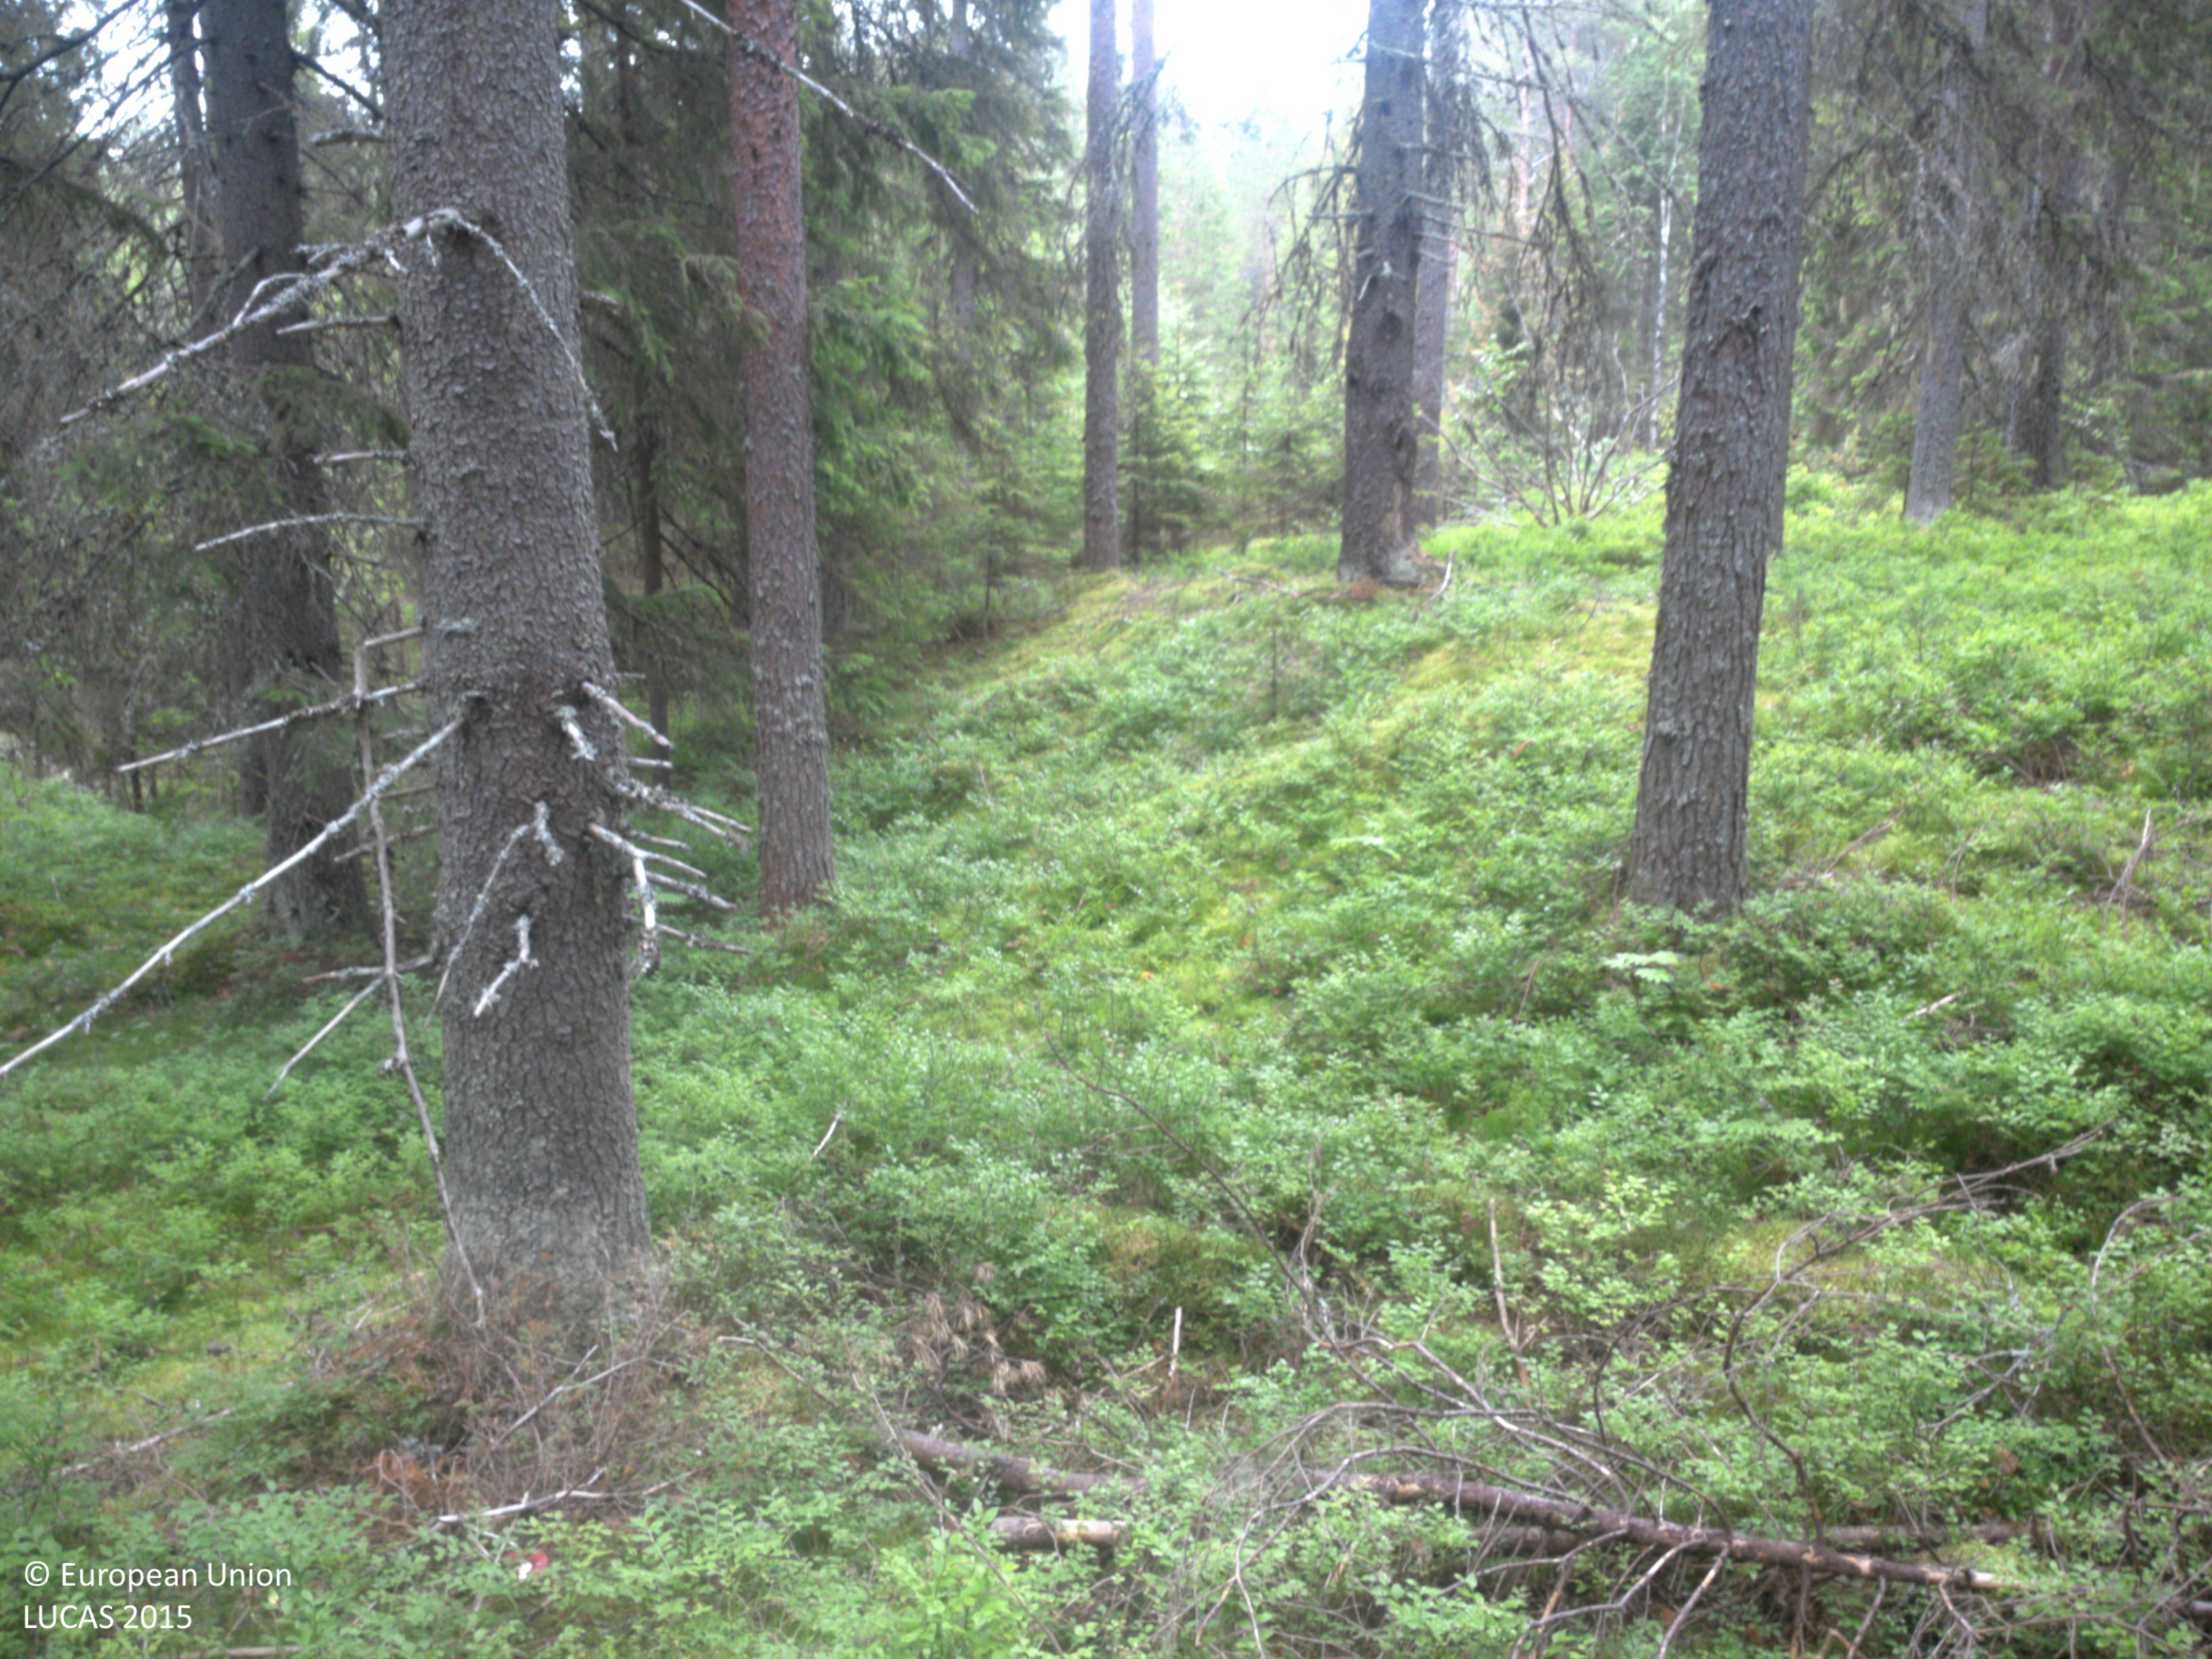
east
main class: Woodland
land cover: Other coniferous woodland
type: boreal forest
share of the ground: 50 - 75 %
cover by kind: coniferous forest trees 50 %, shrubs 40 %, lichens and mosses 10 %
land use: Forestry
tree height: > 5 m
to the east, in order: Other coniferous woodland; Spruce dominated coniferous woodland; Rivers and streams; Spruce dominated coniferous woodland; Other coniferous woodland; Tracks; Rocks and stones; Other coniferous woodland; Pine dominated coniferous woodland
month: August
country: SE
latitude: 63.7197
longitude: 19.6758
